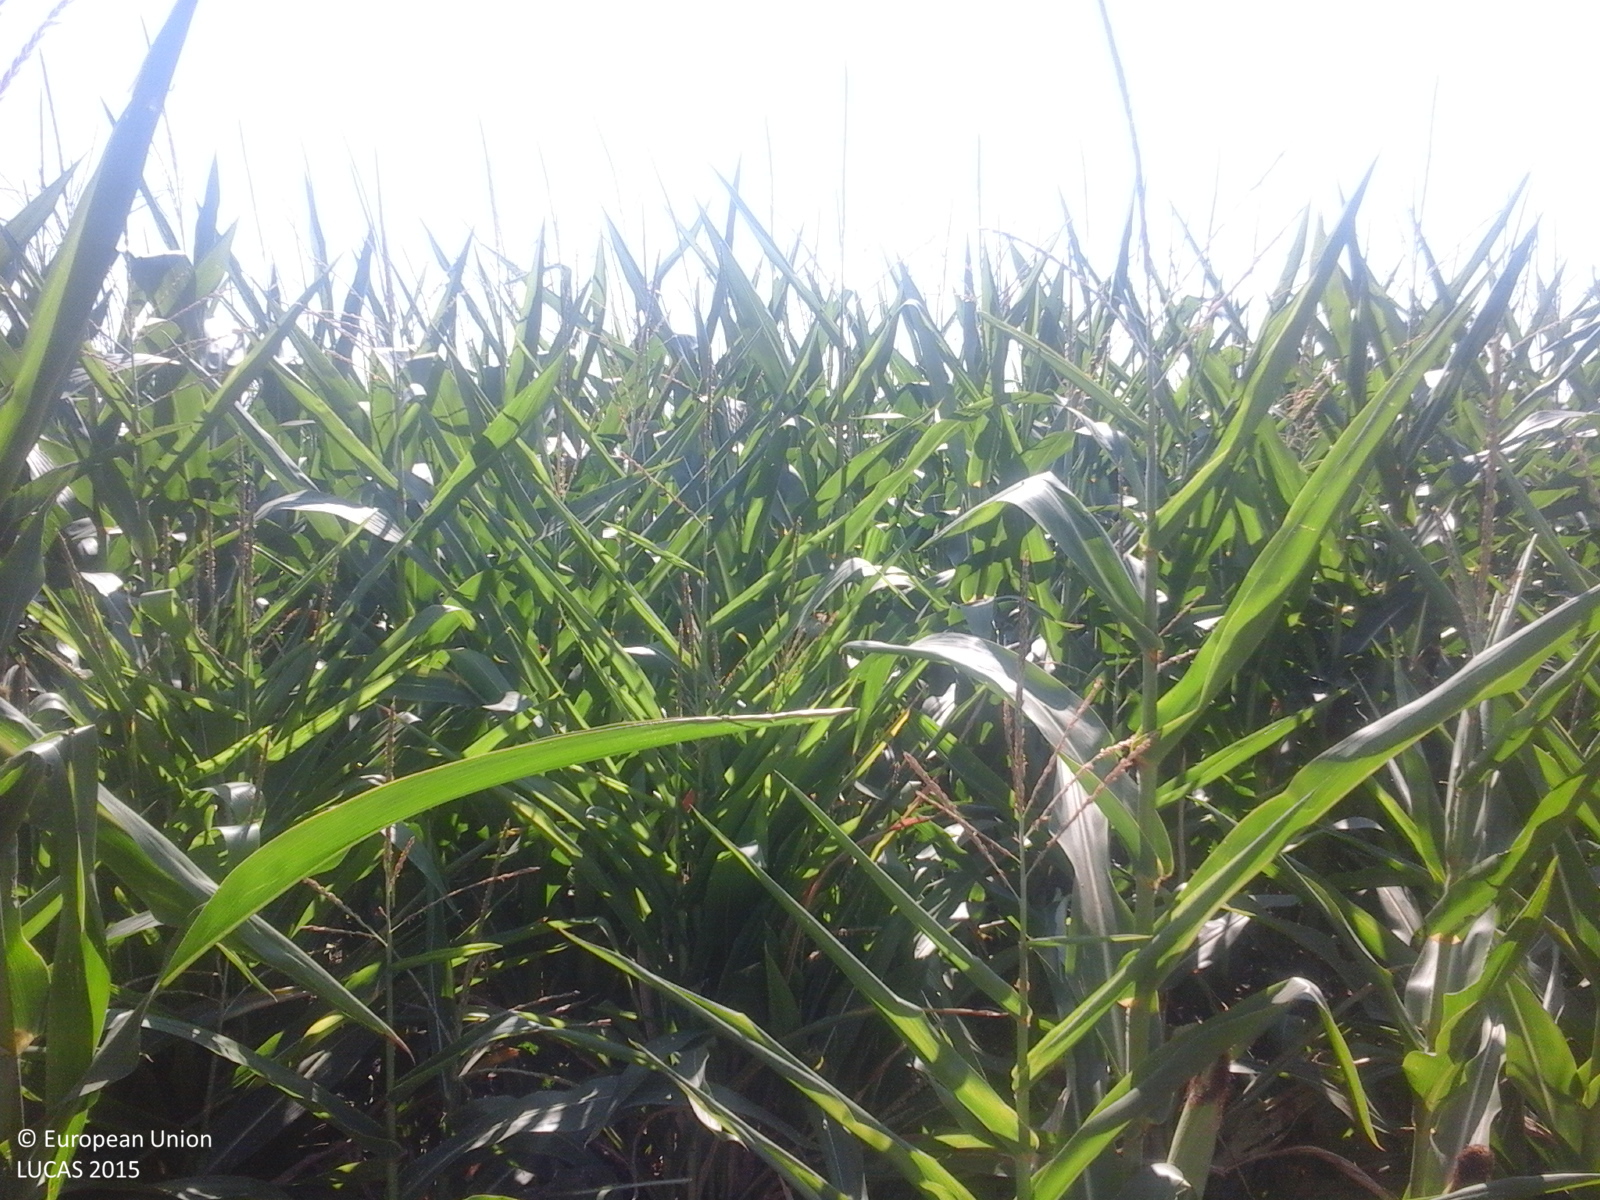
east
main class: Cropland
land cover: Maize
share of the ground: > 75 %
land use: Agriculture (excluding fallow land and kitchen gardens)
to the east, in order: Maize
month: July
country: RO
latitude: 44.8276
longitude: 27.5648
